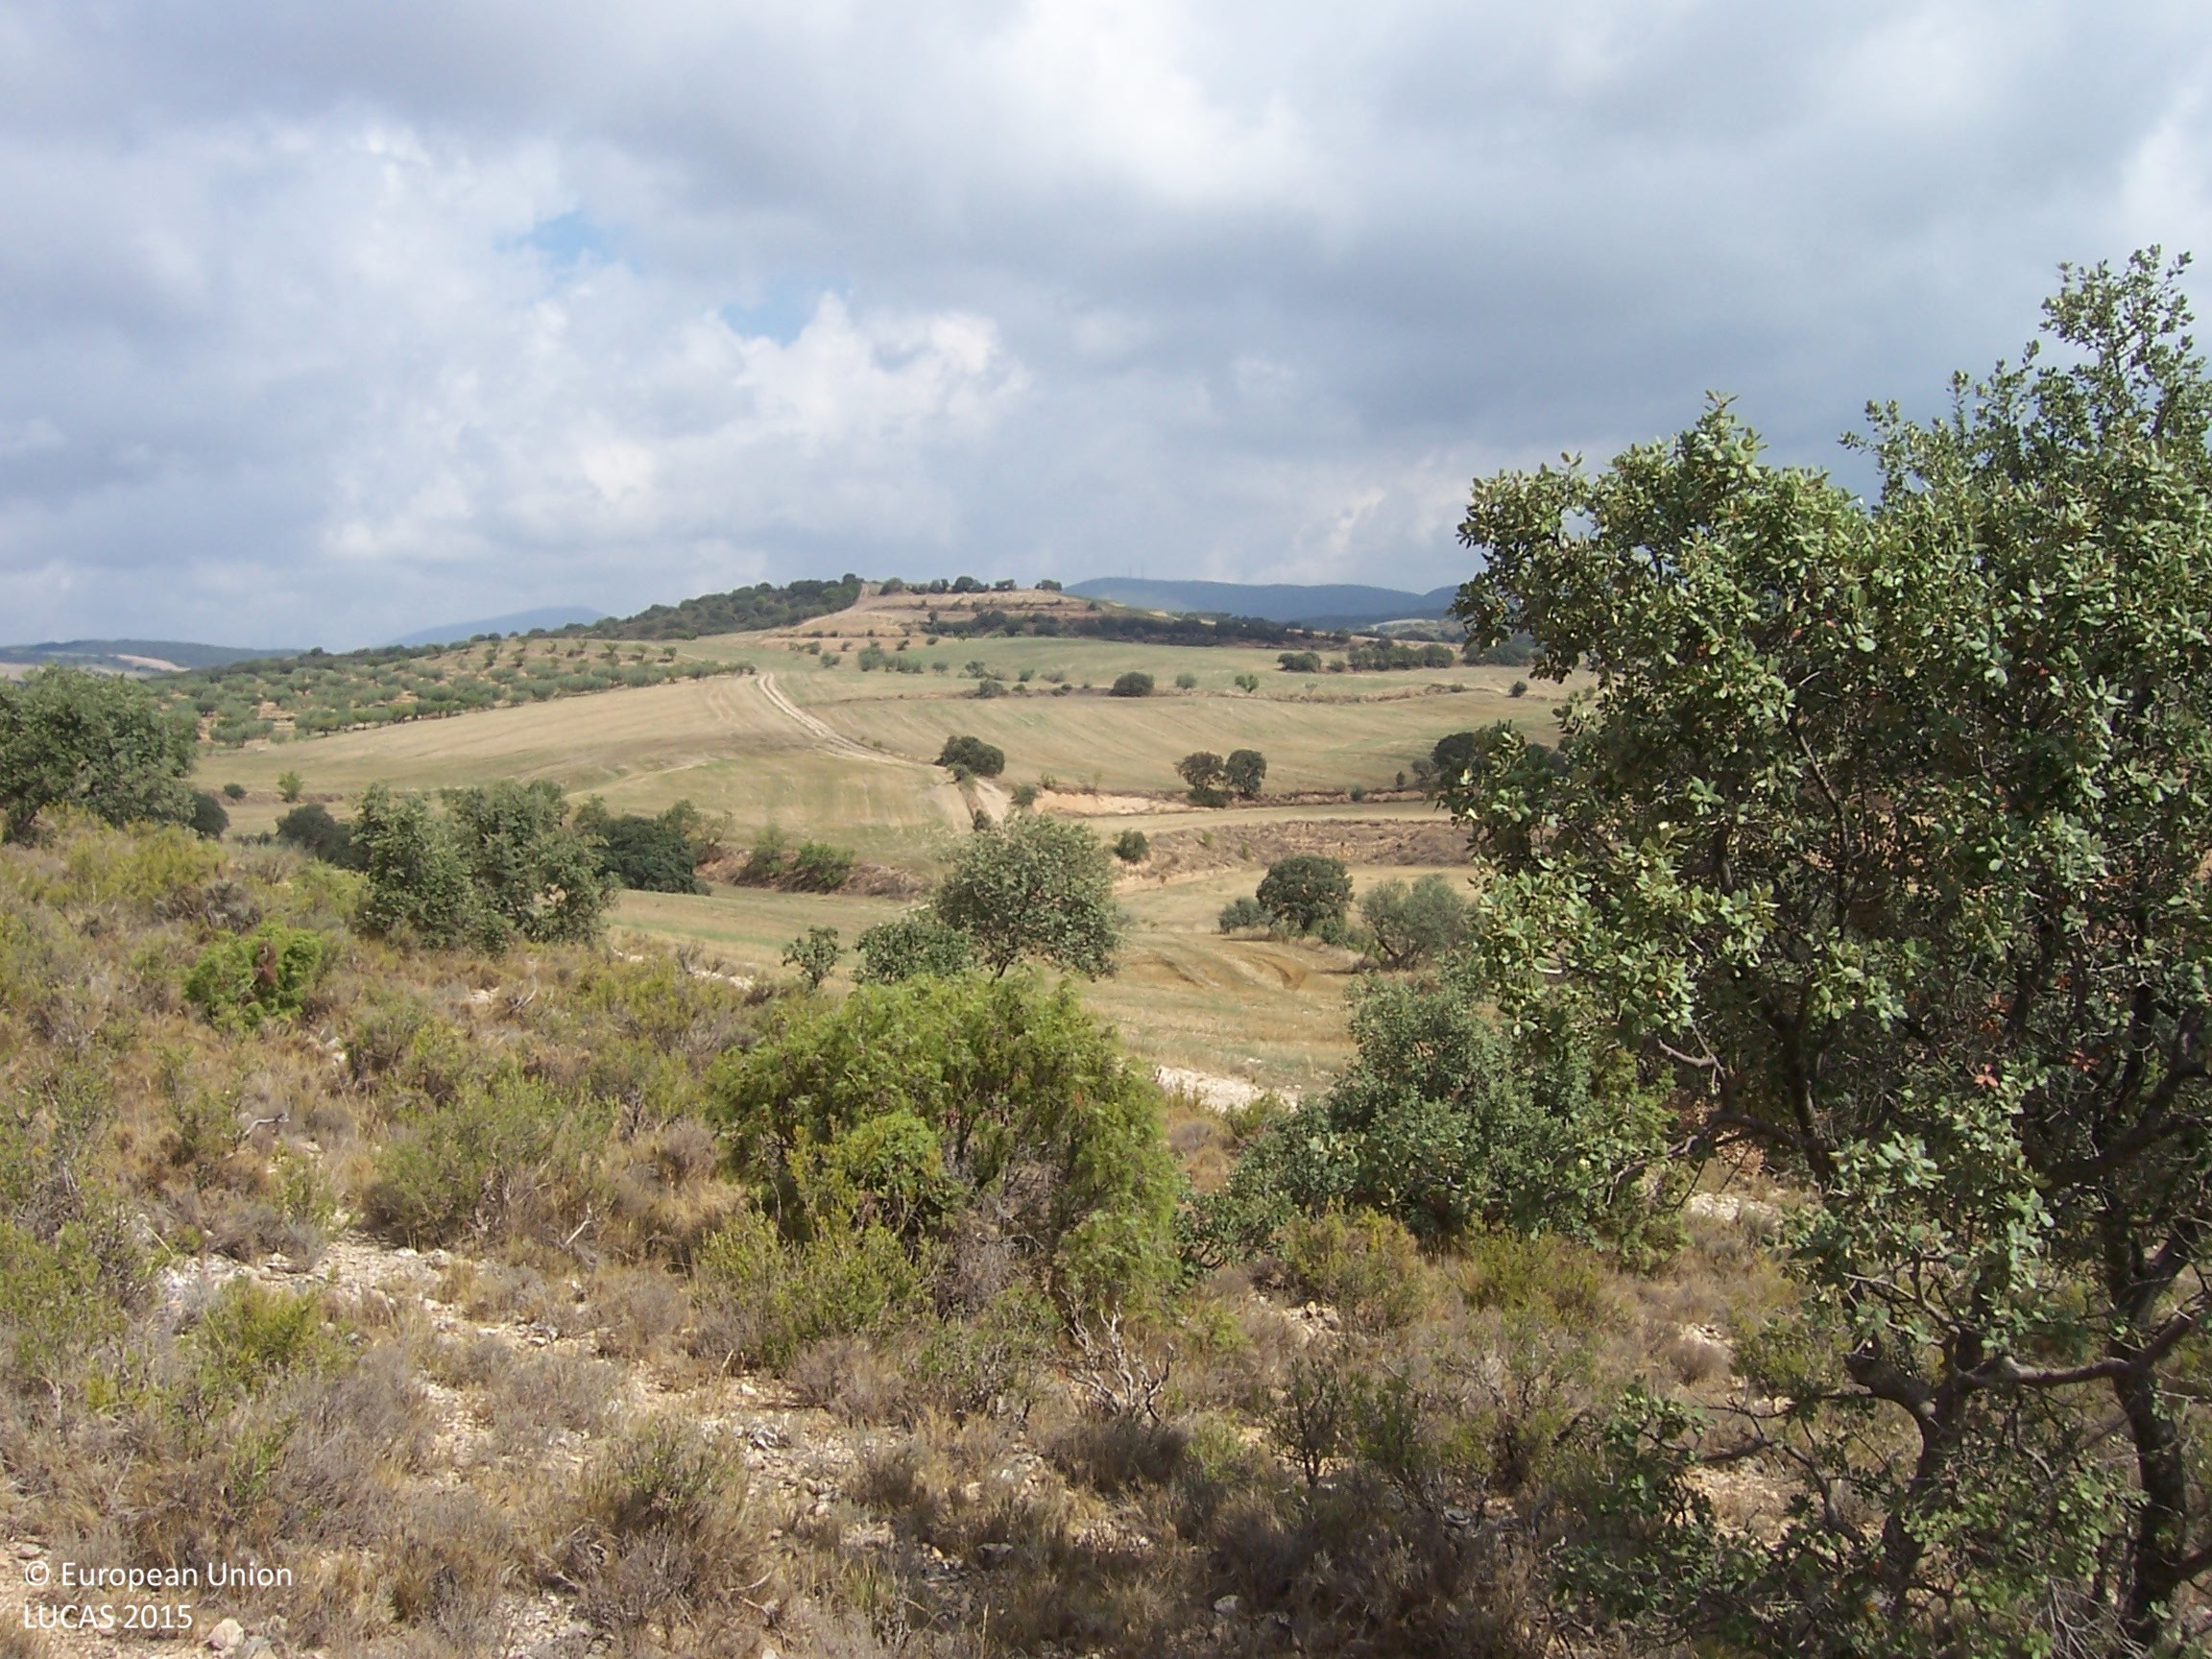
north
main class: Woodland
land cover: Broadleaved woodland
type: broadleaved evergreen forest
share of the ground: > 75 %
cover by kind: herbaceous plants 50 %, shrubs 20 %, broadleaved forest trees 15 %, unconsolidated bare surface 10 %, consolidated bare surface 5 %
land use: Semi-natural and natural areas not in use
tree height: < 5 m
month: August
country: ES
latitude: 41.8975
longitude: 0.4988
